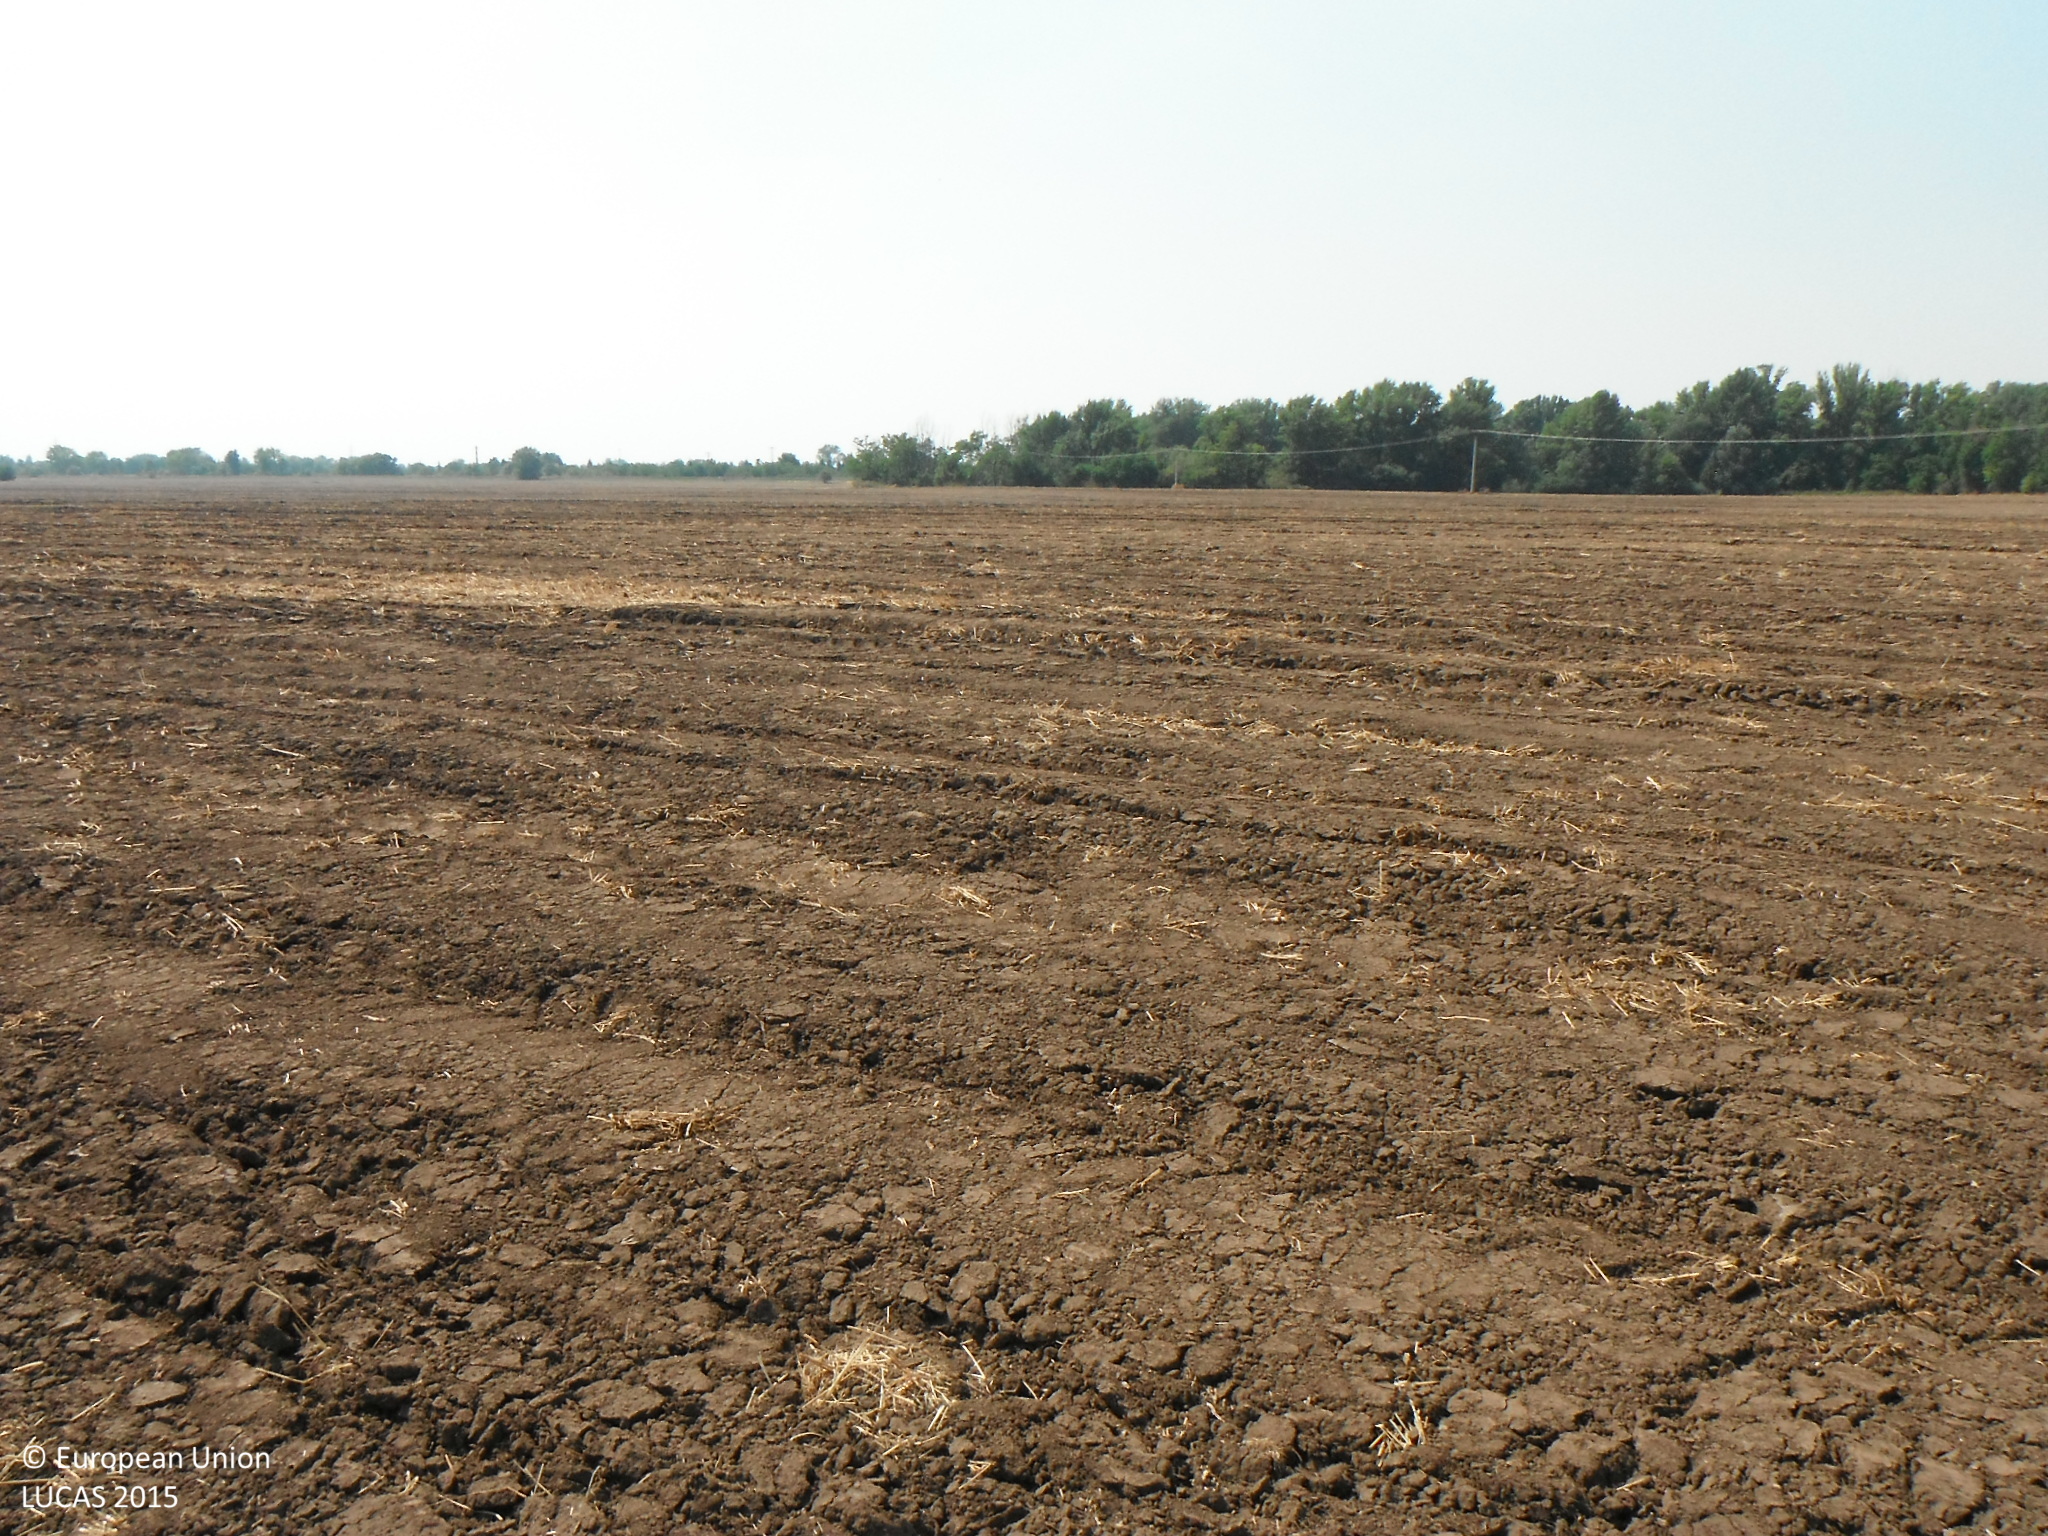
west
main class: Cropland
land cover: Common wheat
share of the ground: < 10 %
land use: Agriculture (excluding fallow land and kitchen gardens)
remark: Harvested field
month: August
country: SK
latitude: 48.0079
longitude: 18.2038
